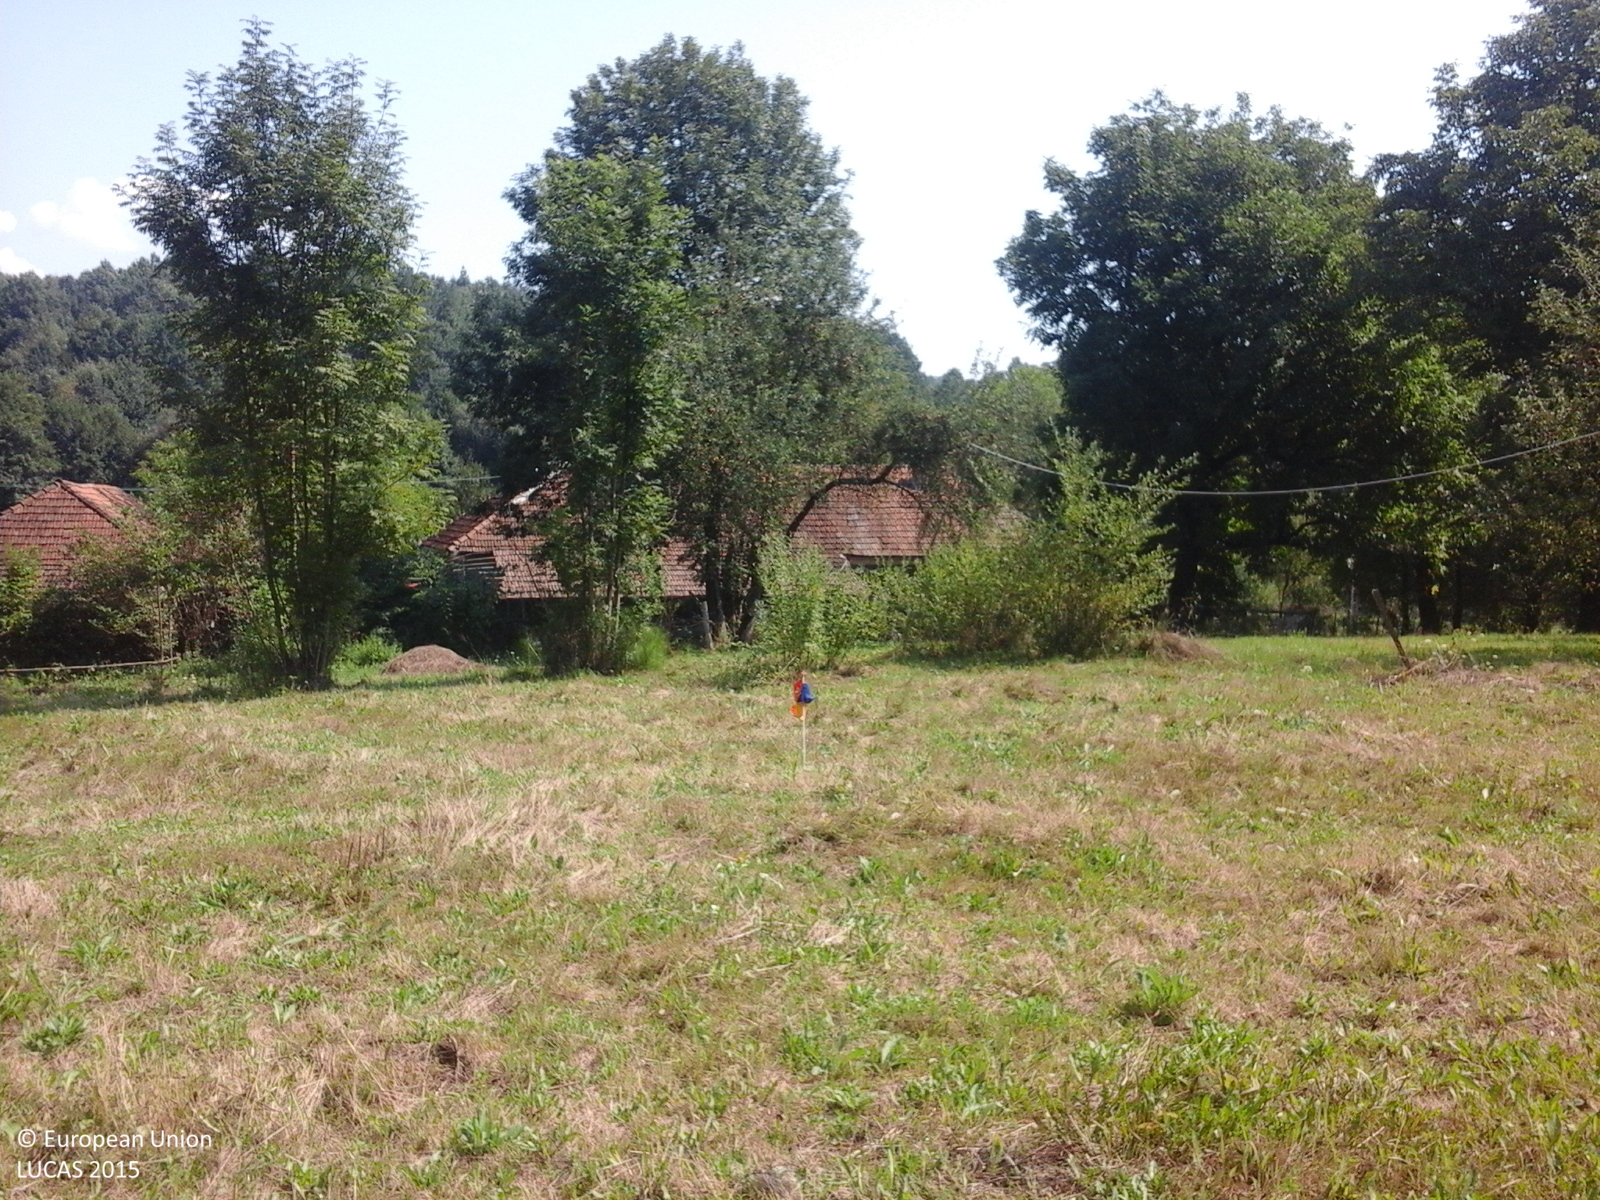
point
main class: Grassland
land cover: Grassland without tree/shrub cover
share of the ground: > 75 %
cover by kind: herbaceous plants 100 %
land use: Agriculture (excluding fallow land and kitchen gardens)
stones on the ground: < 10 %
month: August
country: RO
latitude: 46.3420
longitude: 22.5107
